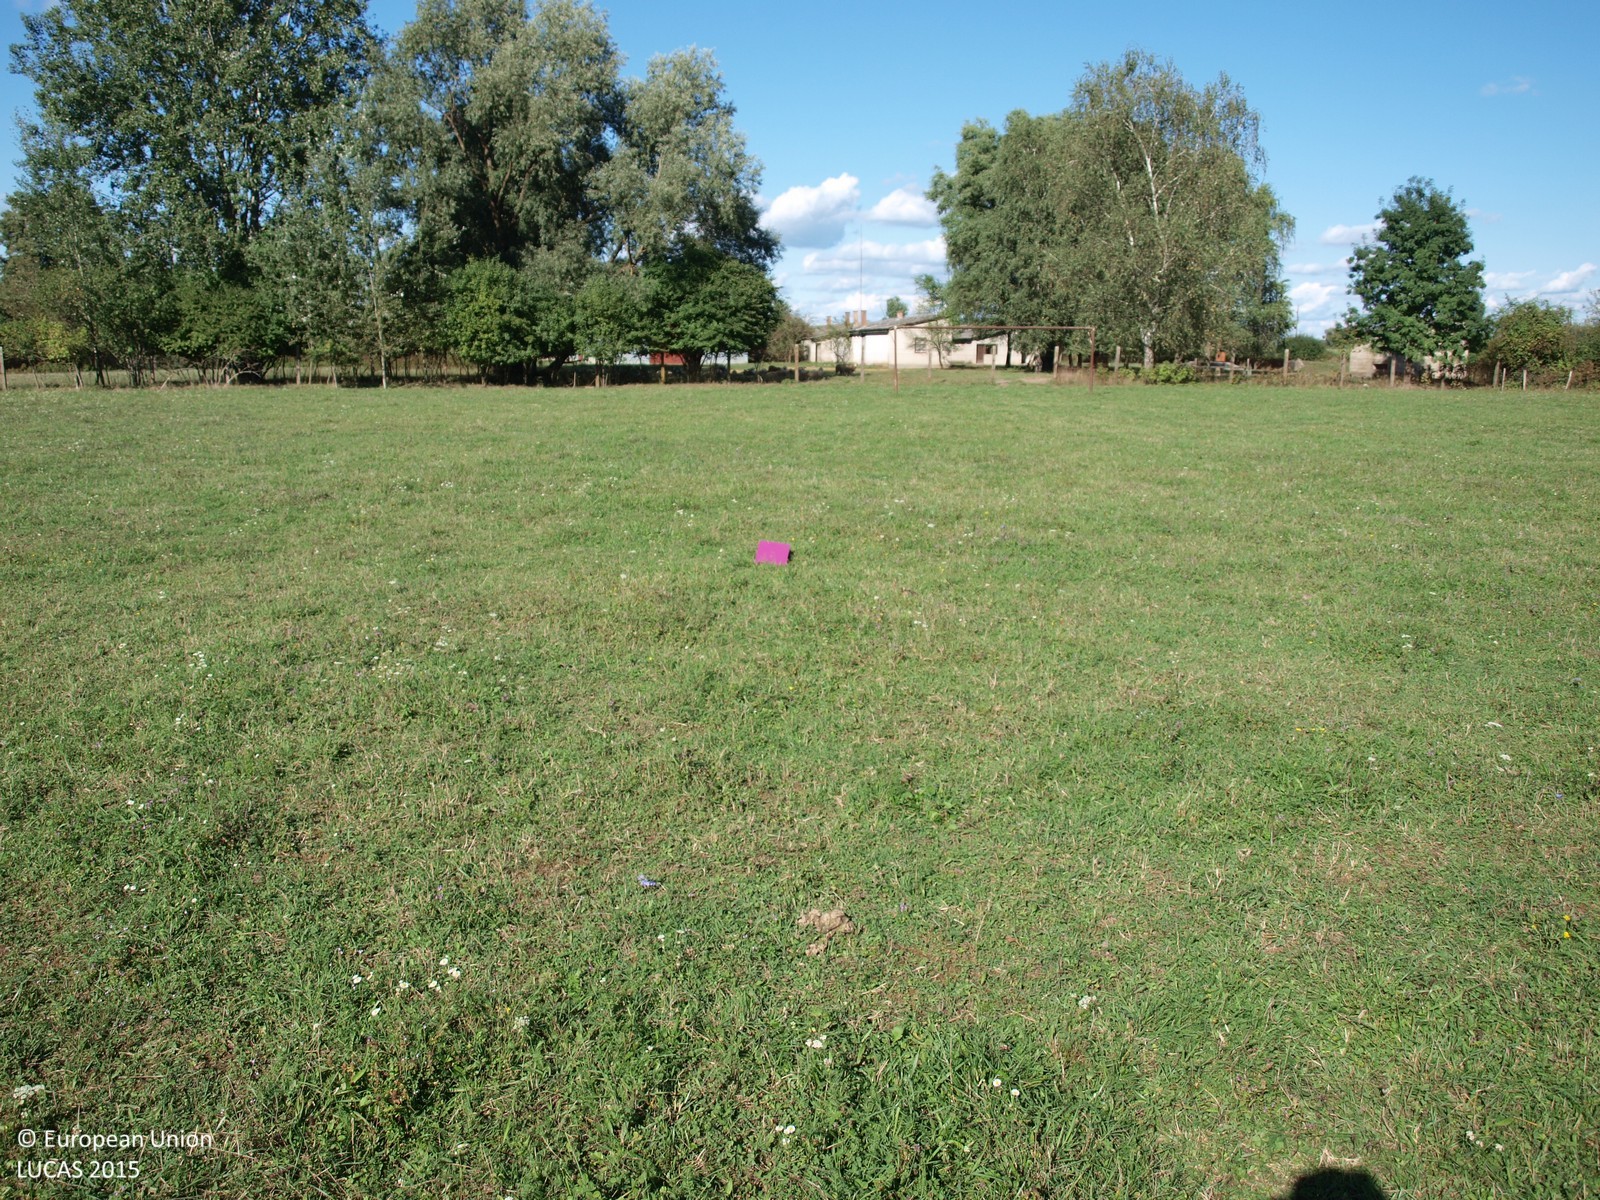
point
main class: Grassland
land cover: Grassland without tree/shrub cover
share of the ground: > 75 %
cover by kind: herbaceous plants 100 %
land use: Agriculture (excluding fallow land and kitchen gardens)
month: September
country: HR
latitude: 45.6565
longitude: 16.3508
